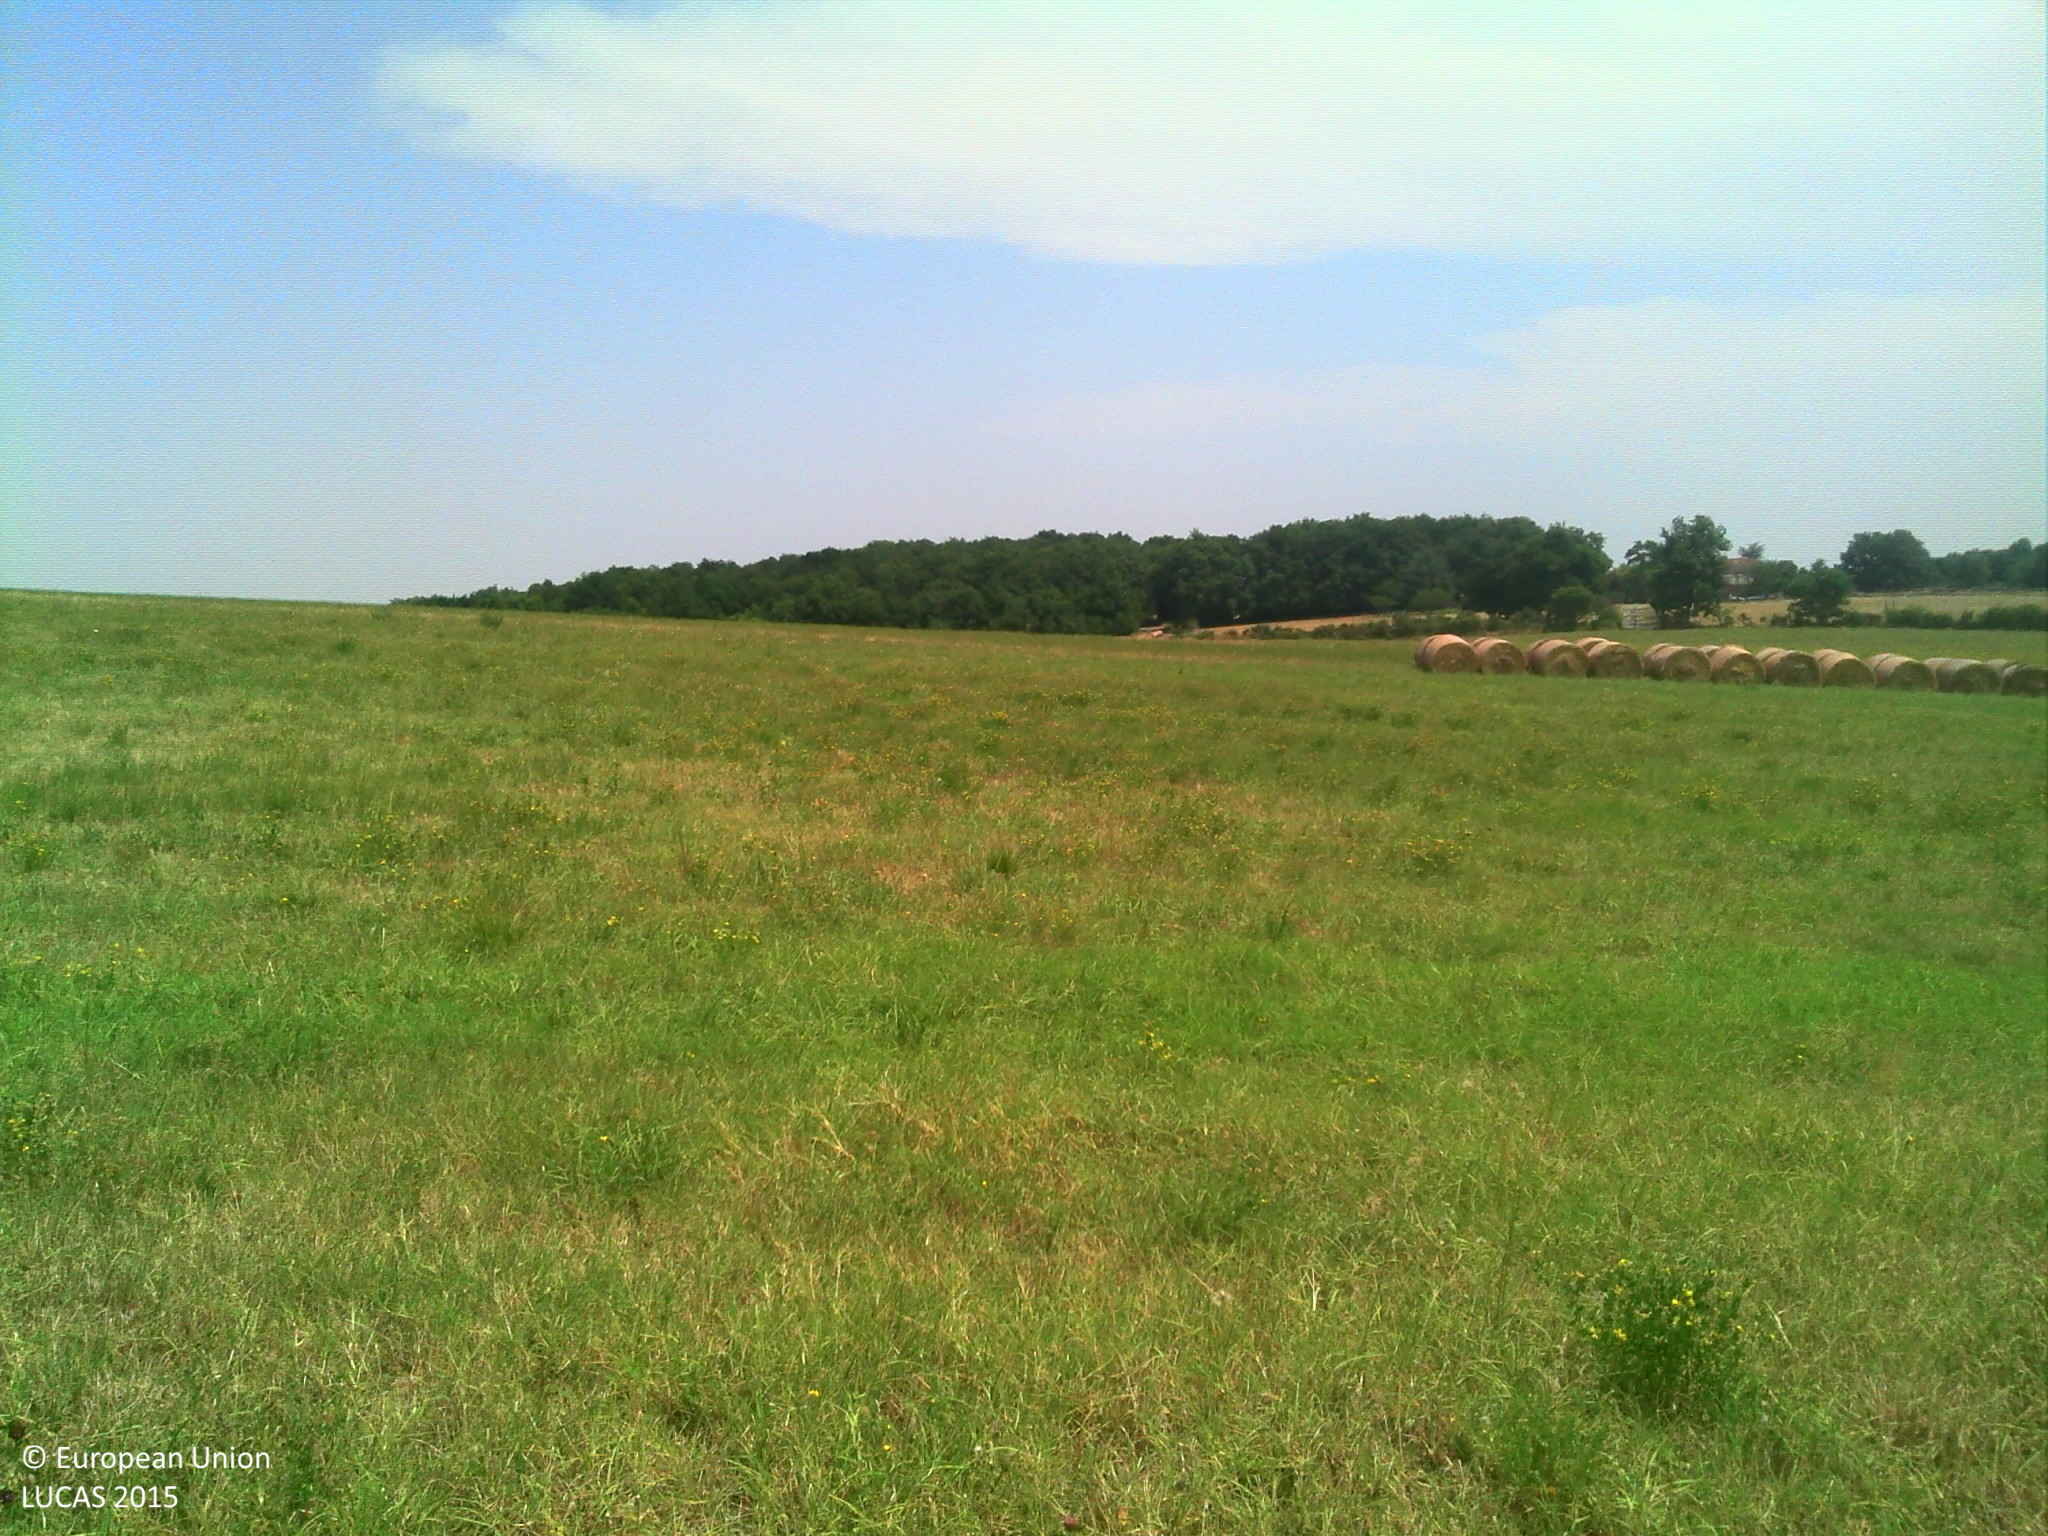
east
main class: Grassland
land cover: Grassland without tree/shrub cover
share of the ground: > 75 %
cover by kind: herbaceous plants 100 %
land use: Agriculture (excluding fallow land and kitchen gardens)
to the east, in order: Grassland without tree/shrub cover; Temporary grasslands; Grass margins; Ditches and canals; Grass margins; Paved roads, cycling and walking lanes; Grass margins; Ditches and canals; Grassland without tree/shrub cover
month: July
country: FR
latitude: 43.3113
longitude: 1.0638
